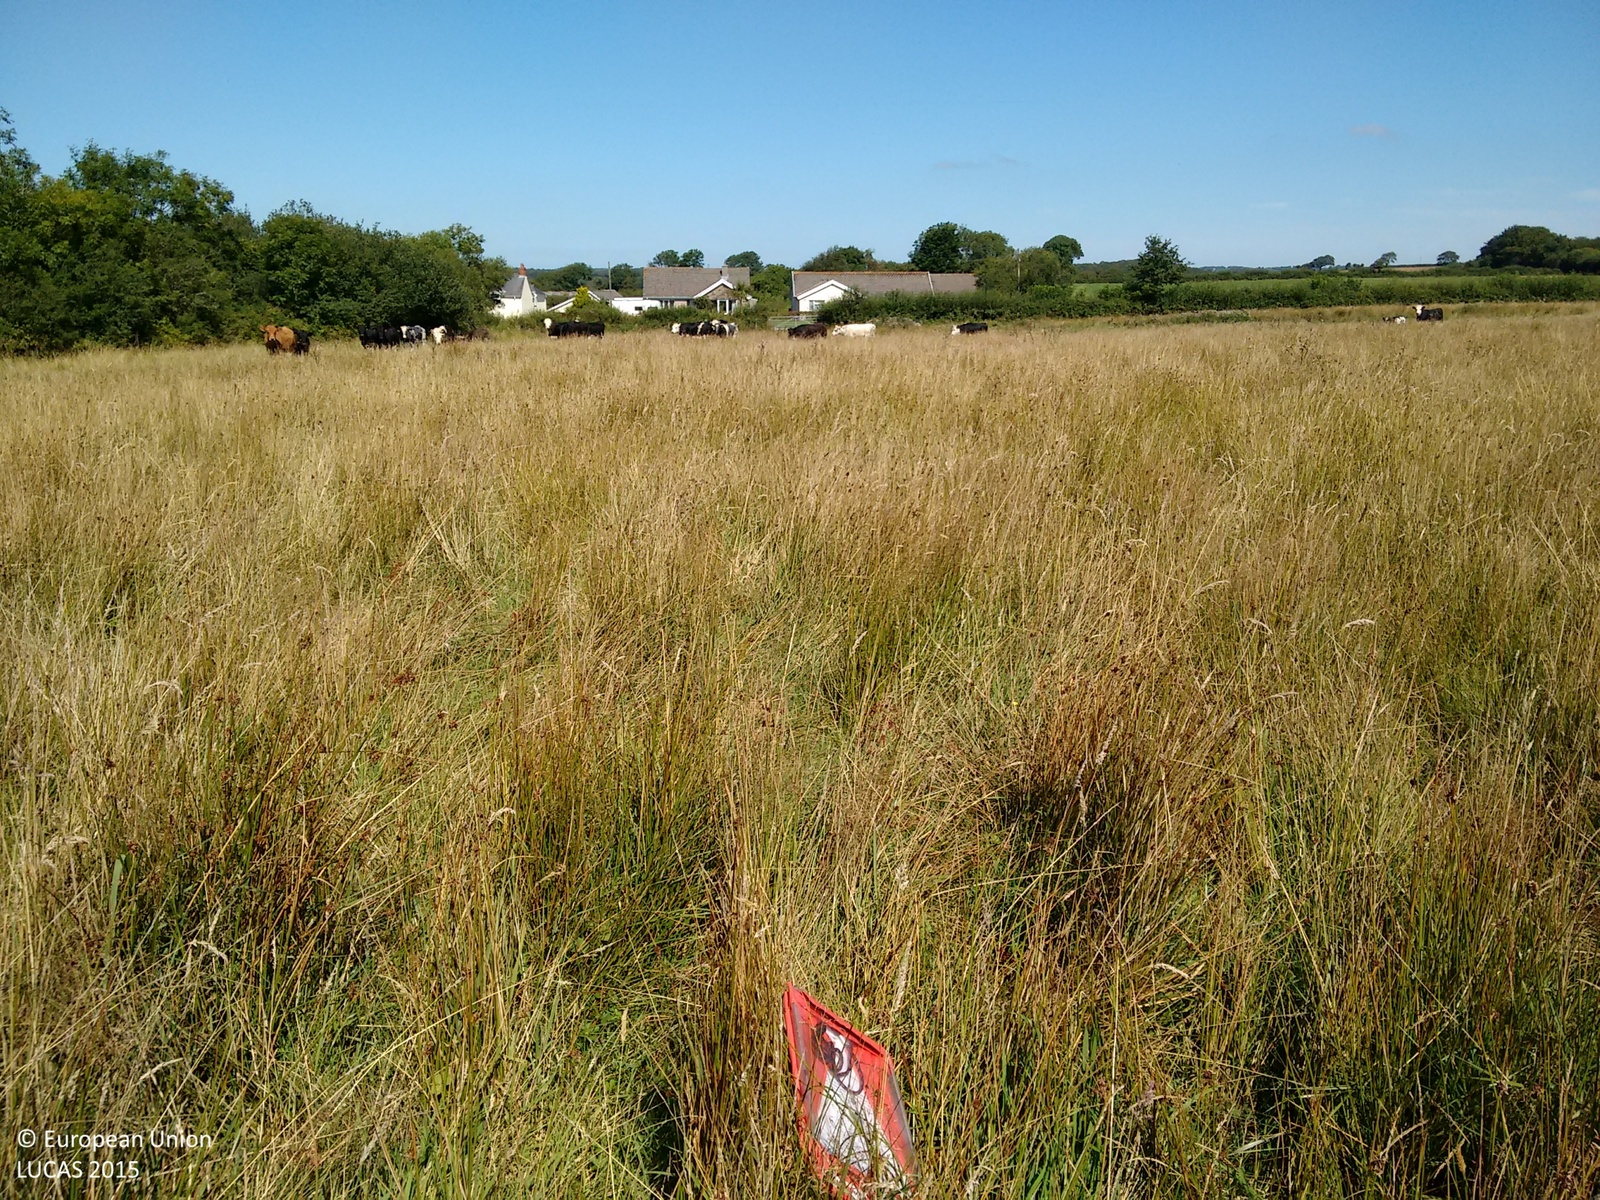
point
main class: Grassland
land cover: Grassland without tree/shrub cover
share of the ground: > 75 %
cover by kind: herbaceous plants 100 %
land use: Agriculture (excluding fallow land and kitchen gardens)
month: August
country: GB
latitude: 51.7129
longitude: -4.8323
